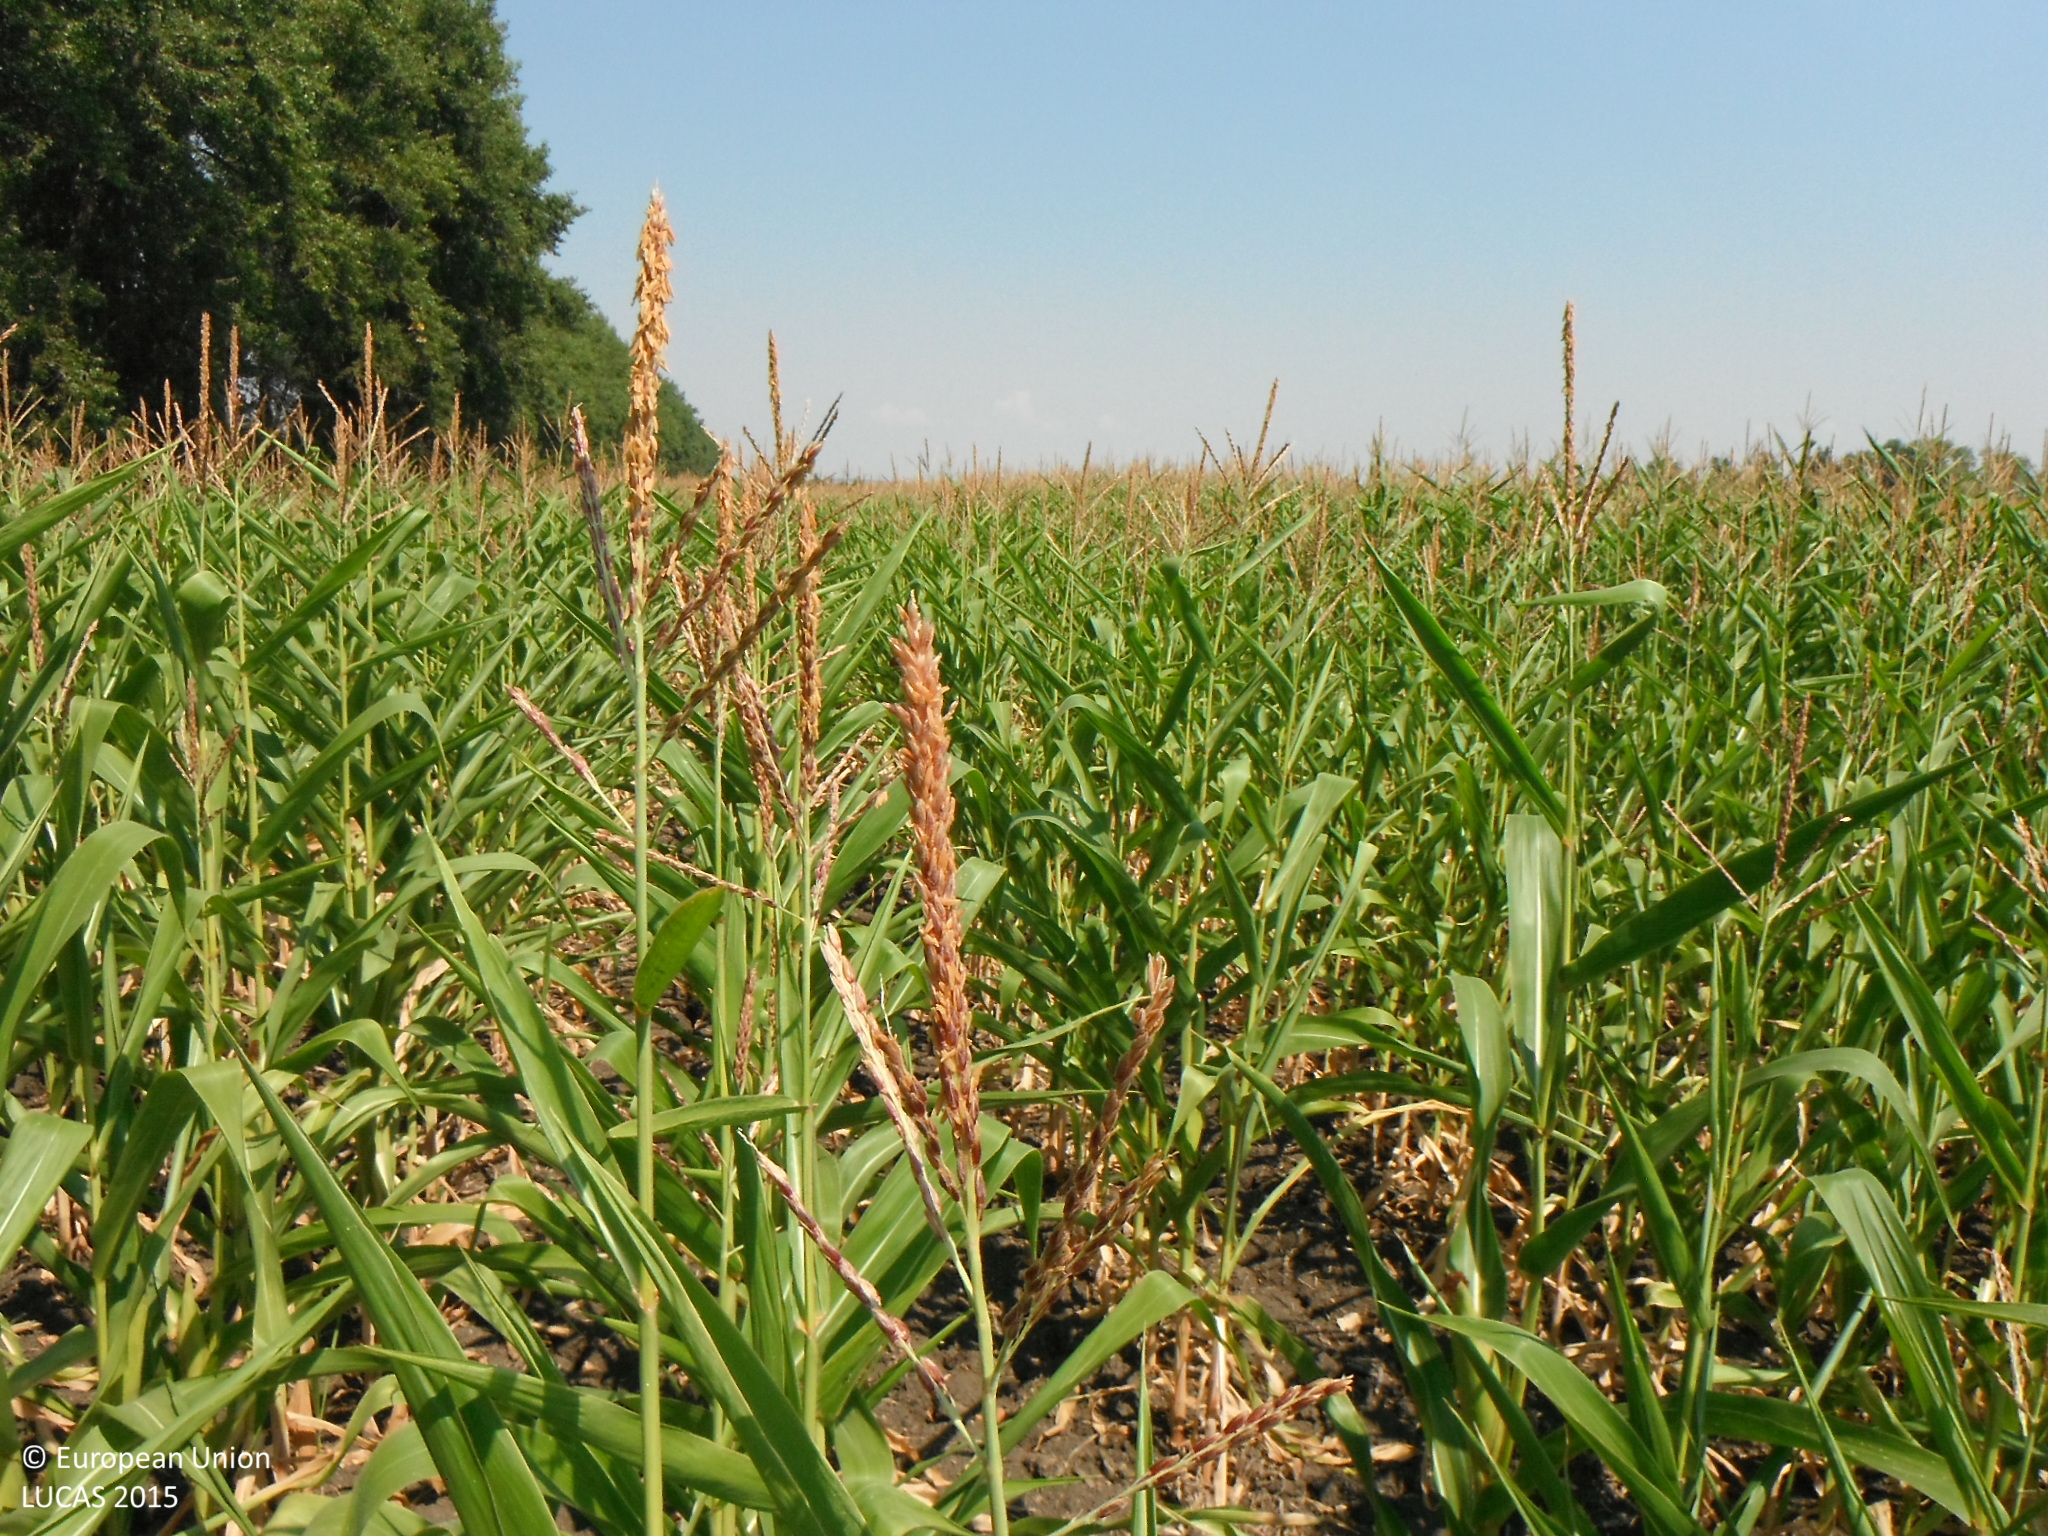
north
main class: Cropland
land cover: Maize
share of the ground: > 75 %
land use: Agriculture (excluding fallow land and kitchen gardens)
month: August
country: SK
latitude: 48.0773
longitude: 18.2421
